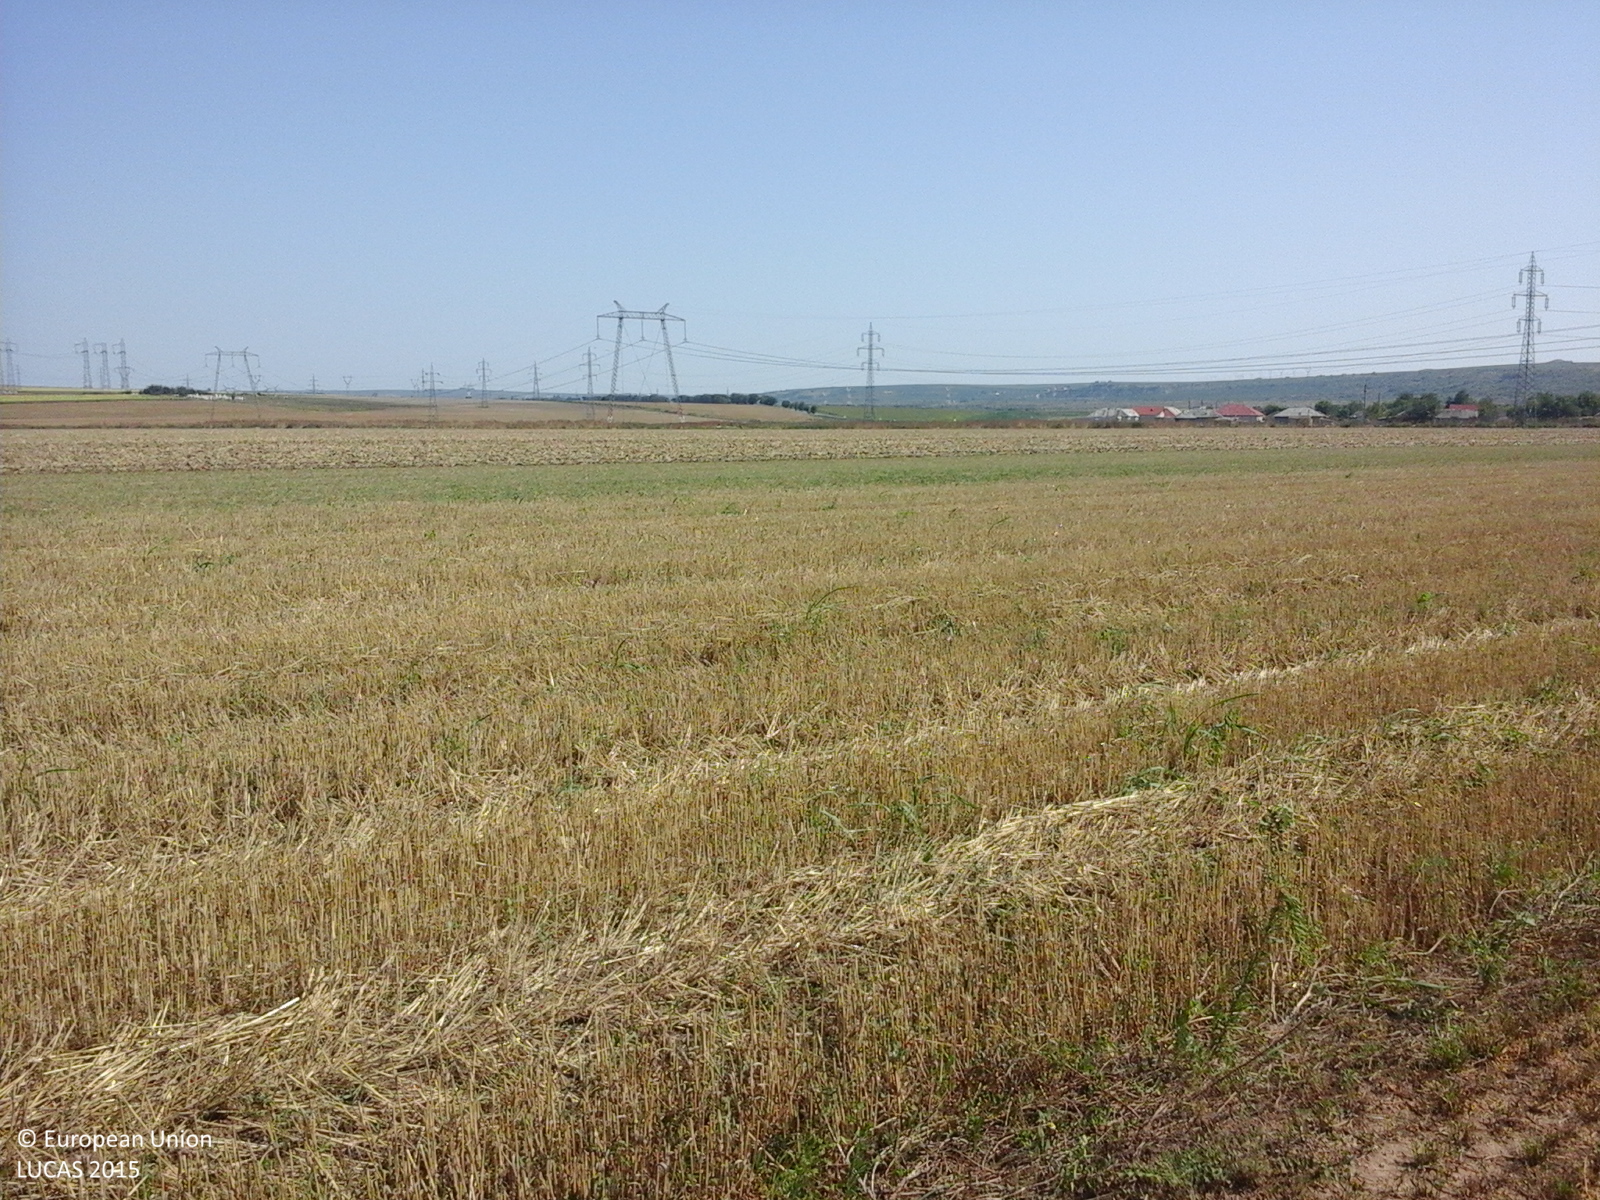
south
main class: Cropland
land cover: Lucerne
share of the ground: 10 - 25 %
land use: Agriculture (excluding fallow land and kitchen gardens)
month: August
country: RO
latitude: 44.2673
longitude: 28.3429
